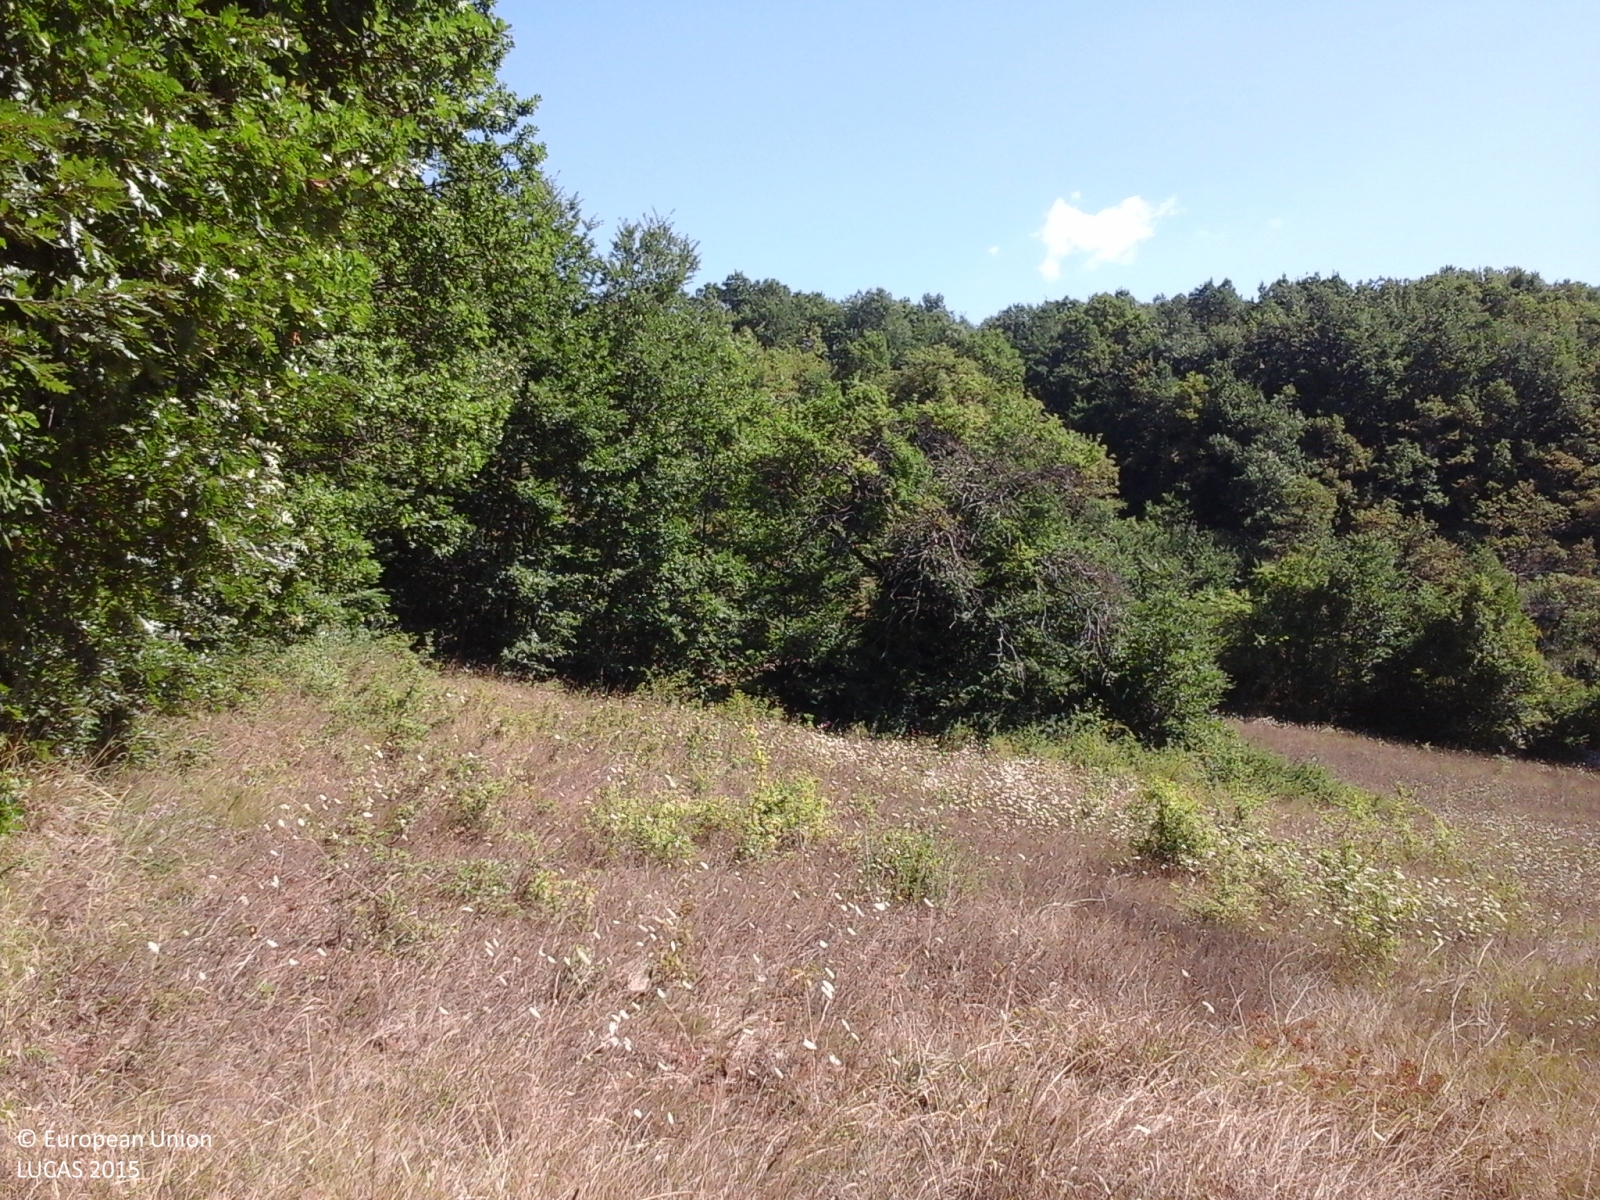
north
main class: Woodland
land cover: Broadleaved woodland
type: thermophilous deciduous forest
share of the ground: > 75 %
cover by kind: broadleaved forest trees 100 %
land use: Forestry
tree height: > 5 m
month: August
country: IT
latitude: 42.2066
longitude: 13.1747
